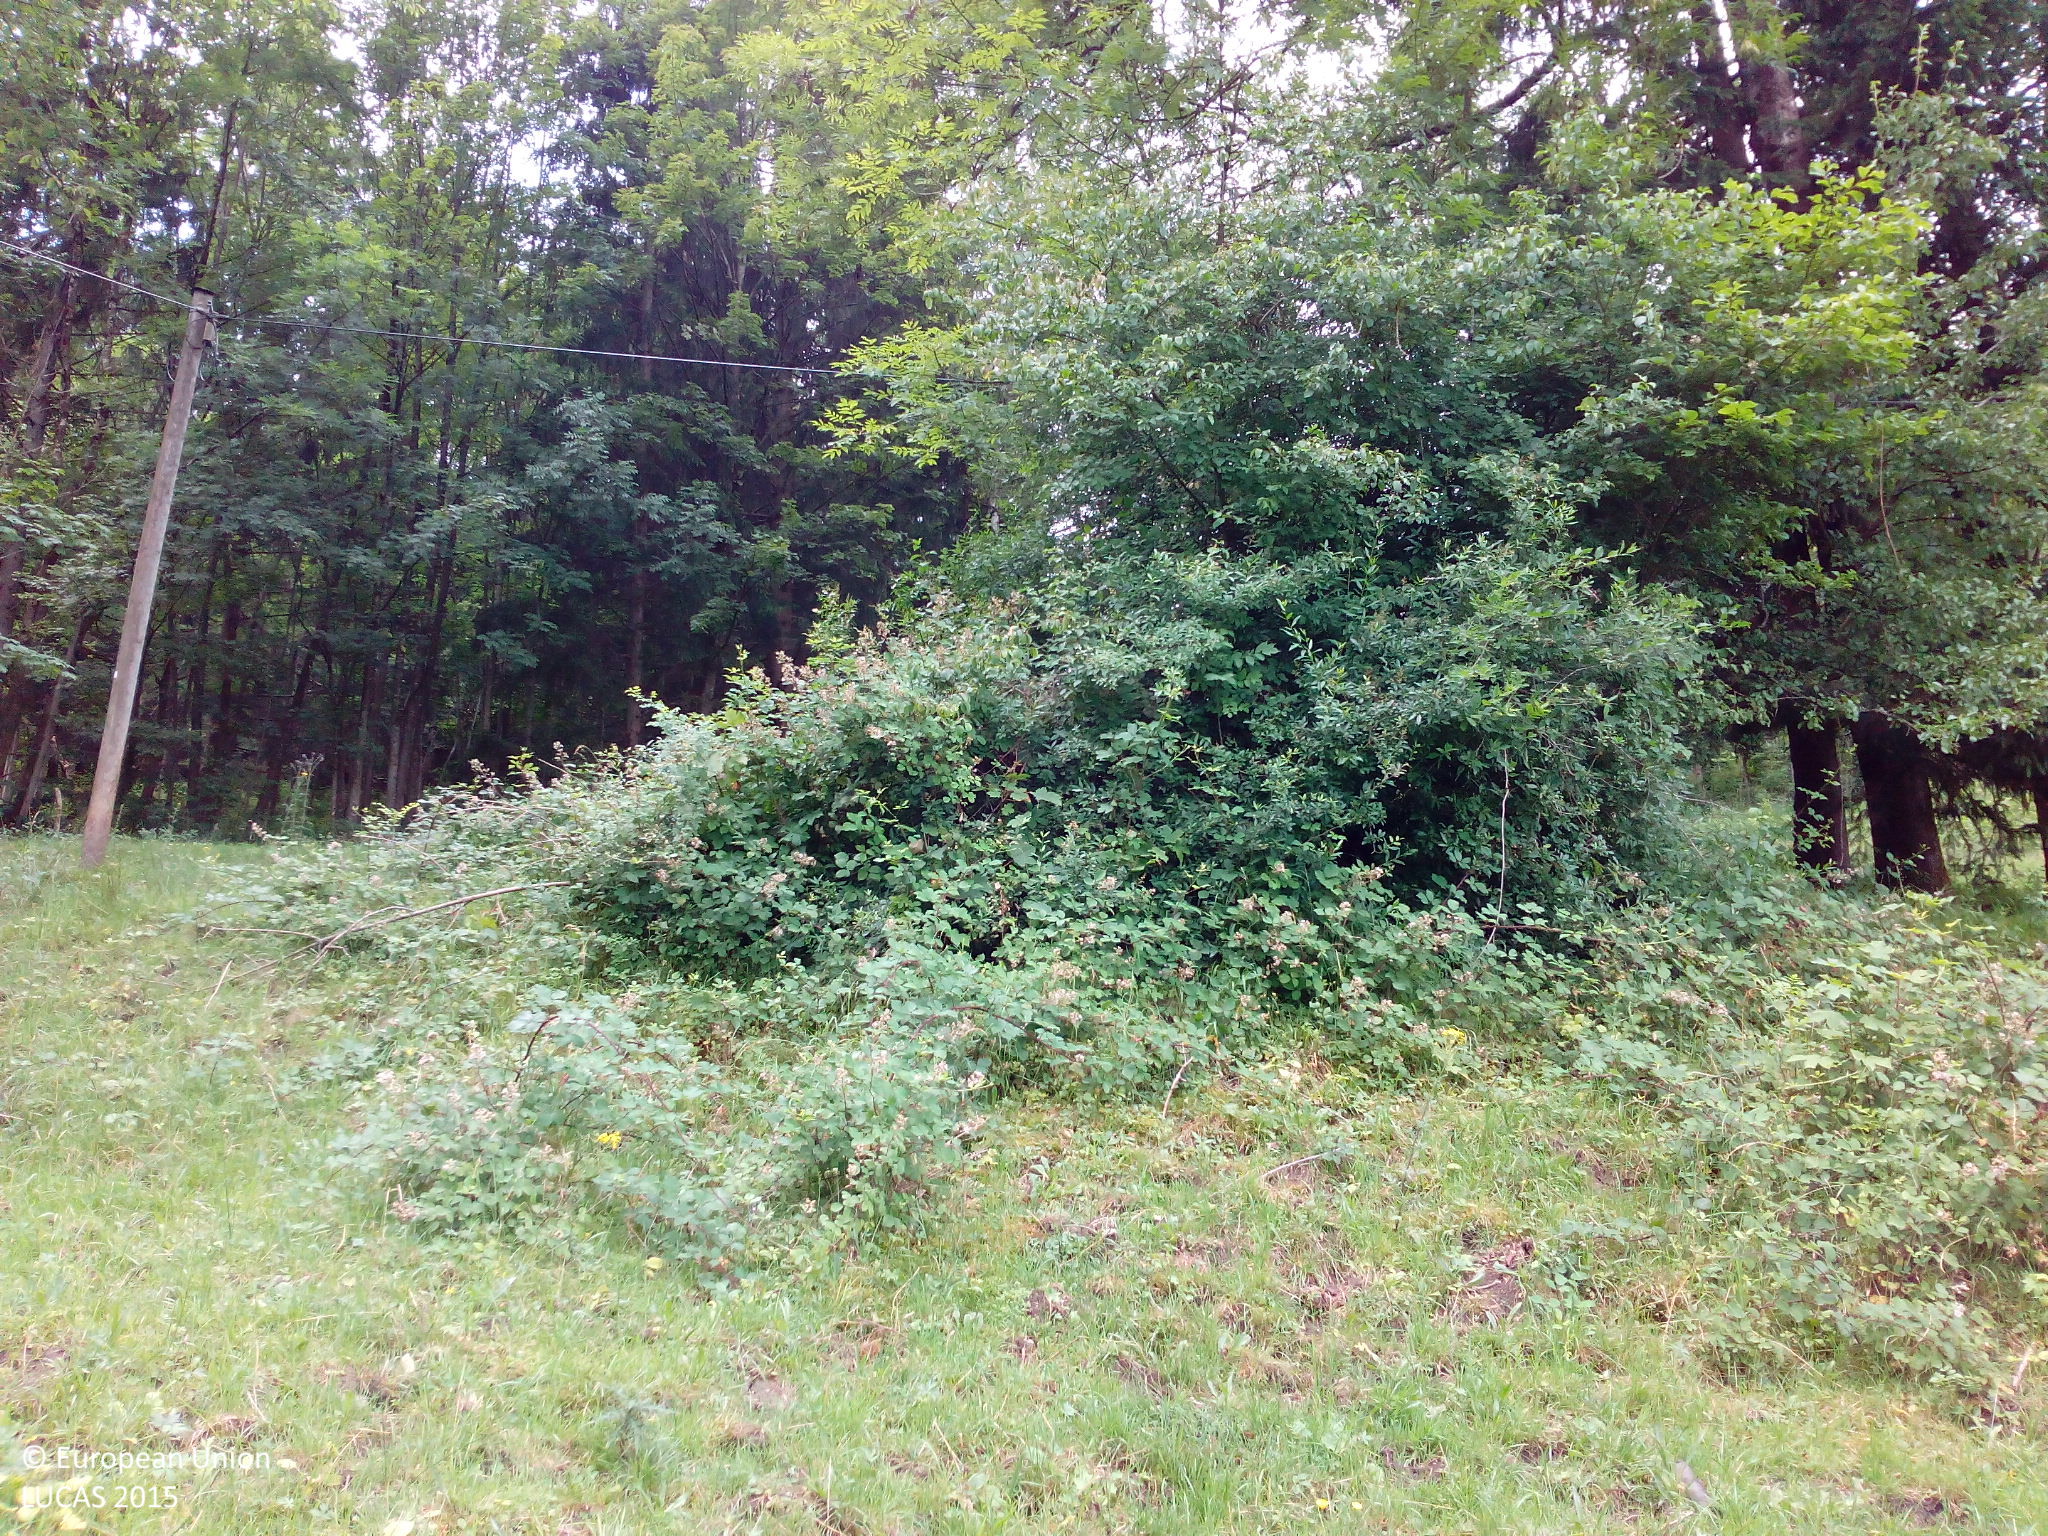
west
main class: Grassland
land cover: Grassland without tree/shrub cover
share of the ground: > 75 %
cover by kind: herbaceous plants 100 %
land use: Agriculture (excluding fallow land and kitchen gardens)
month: July
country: DE
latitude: 47.7445
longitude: 11.5593
